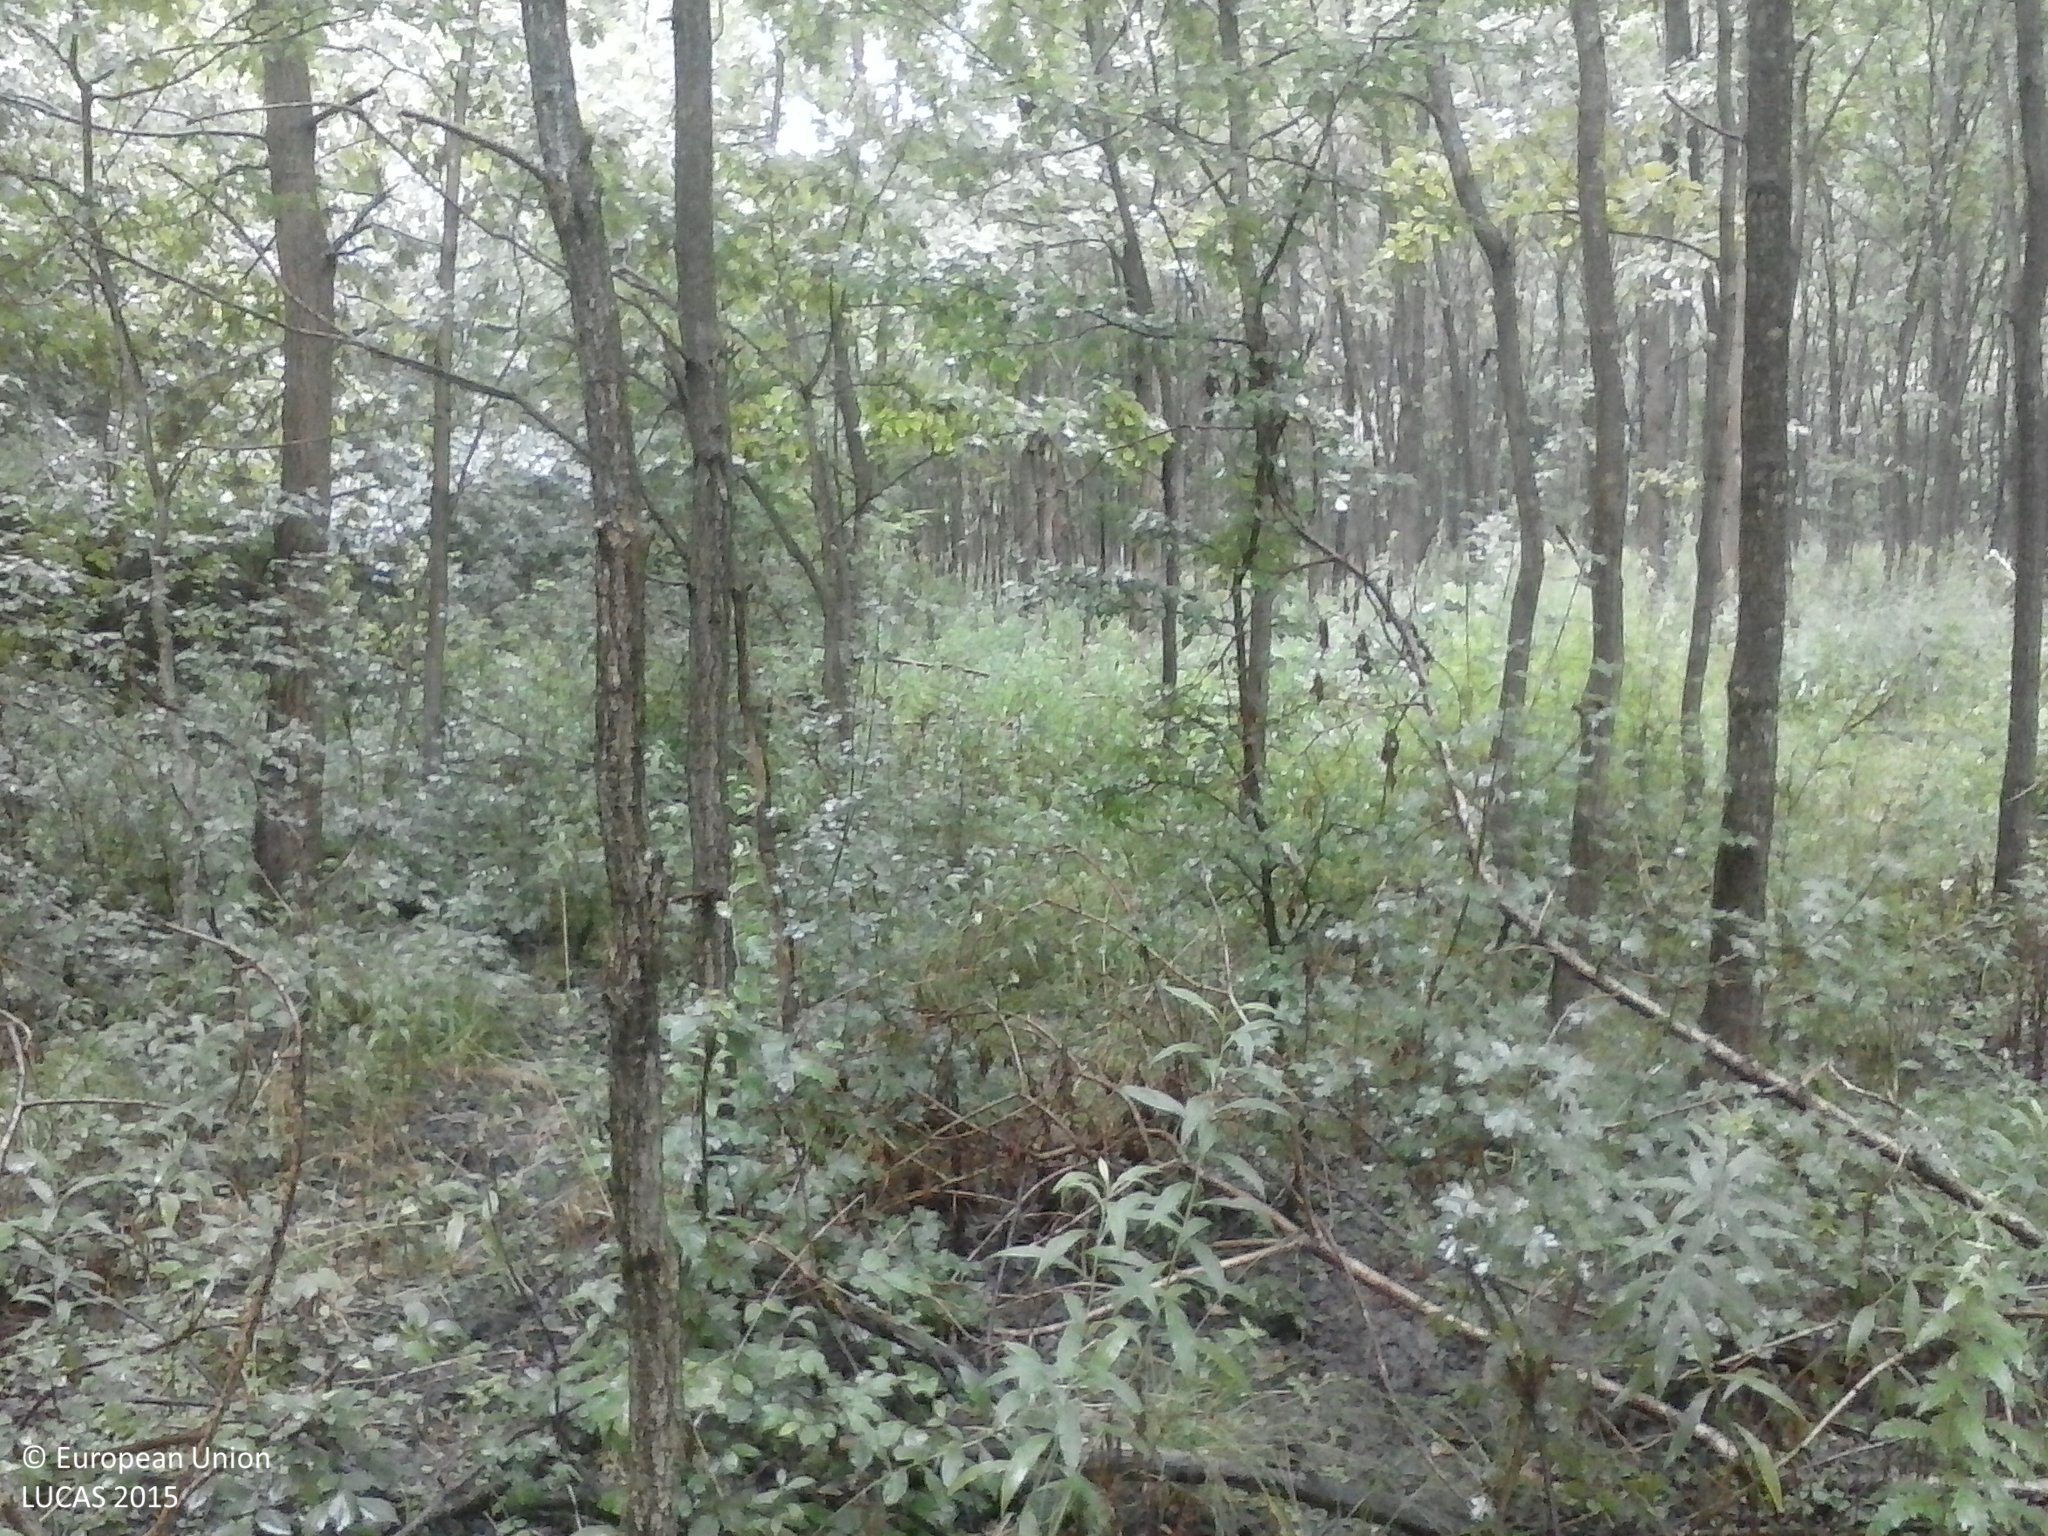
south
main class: Woodland
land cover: Broadleaved woodland
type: exotic forest
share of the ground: > 75 %
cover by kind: broadleaved forest trees 90 %, shrubs 5 %, herbaceous plants 5 %
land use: Forestry
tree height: > 5 m
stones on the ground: < 10 %
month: July
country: HU
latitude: 45.9519
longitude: 17.6283
